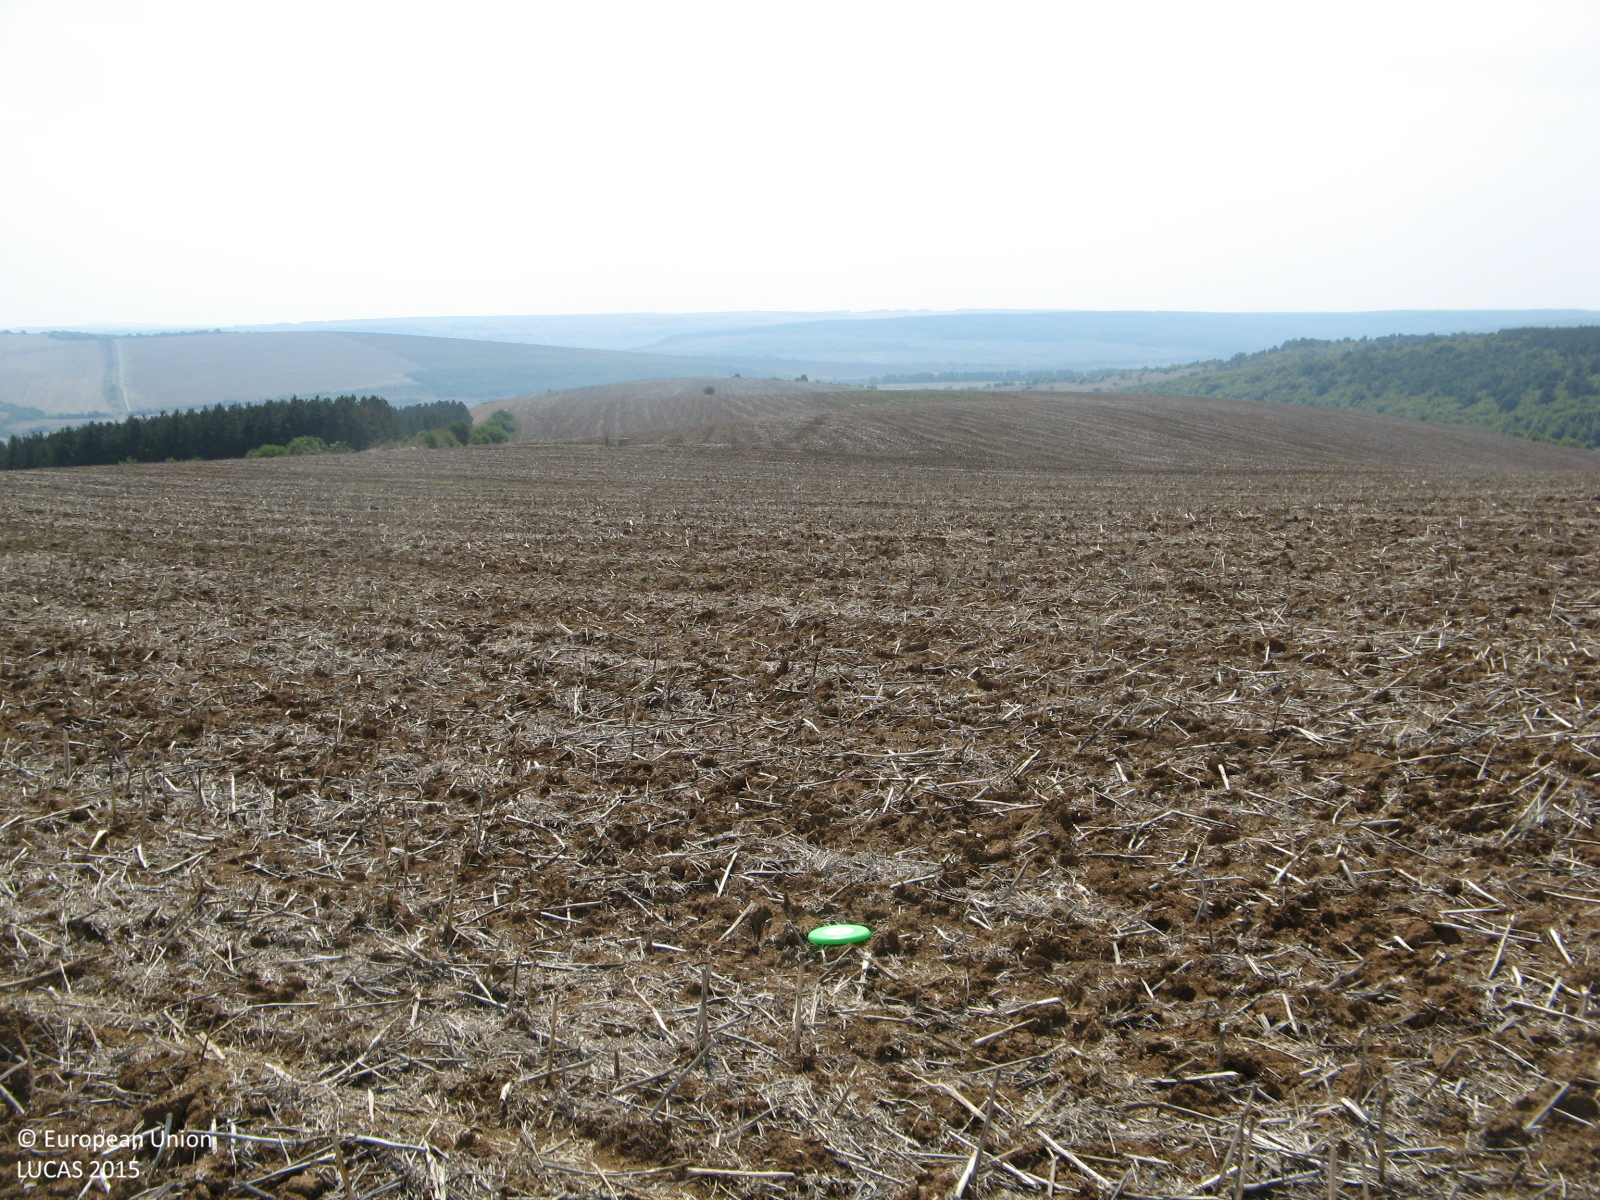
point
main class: Cropland
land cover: Rape and turnip rape
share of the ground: < 10 %
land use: Agriculture (excluding fallow land and kitchen gardens)
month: August
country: BG
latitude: 43.3976
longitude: 25.8549
